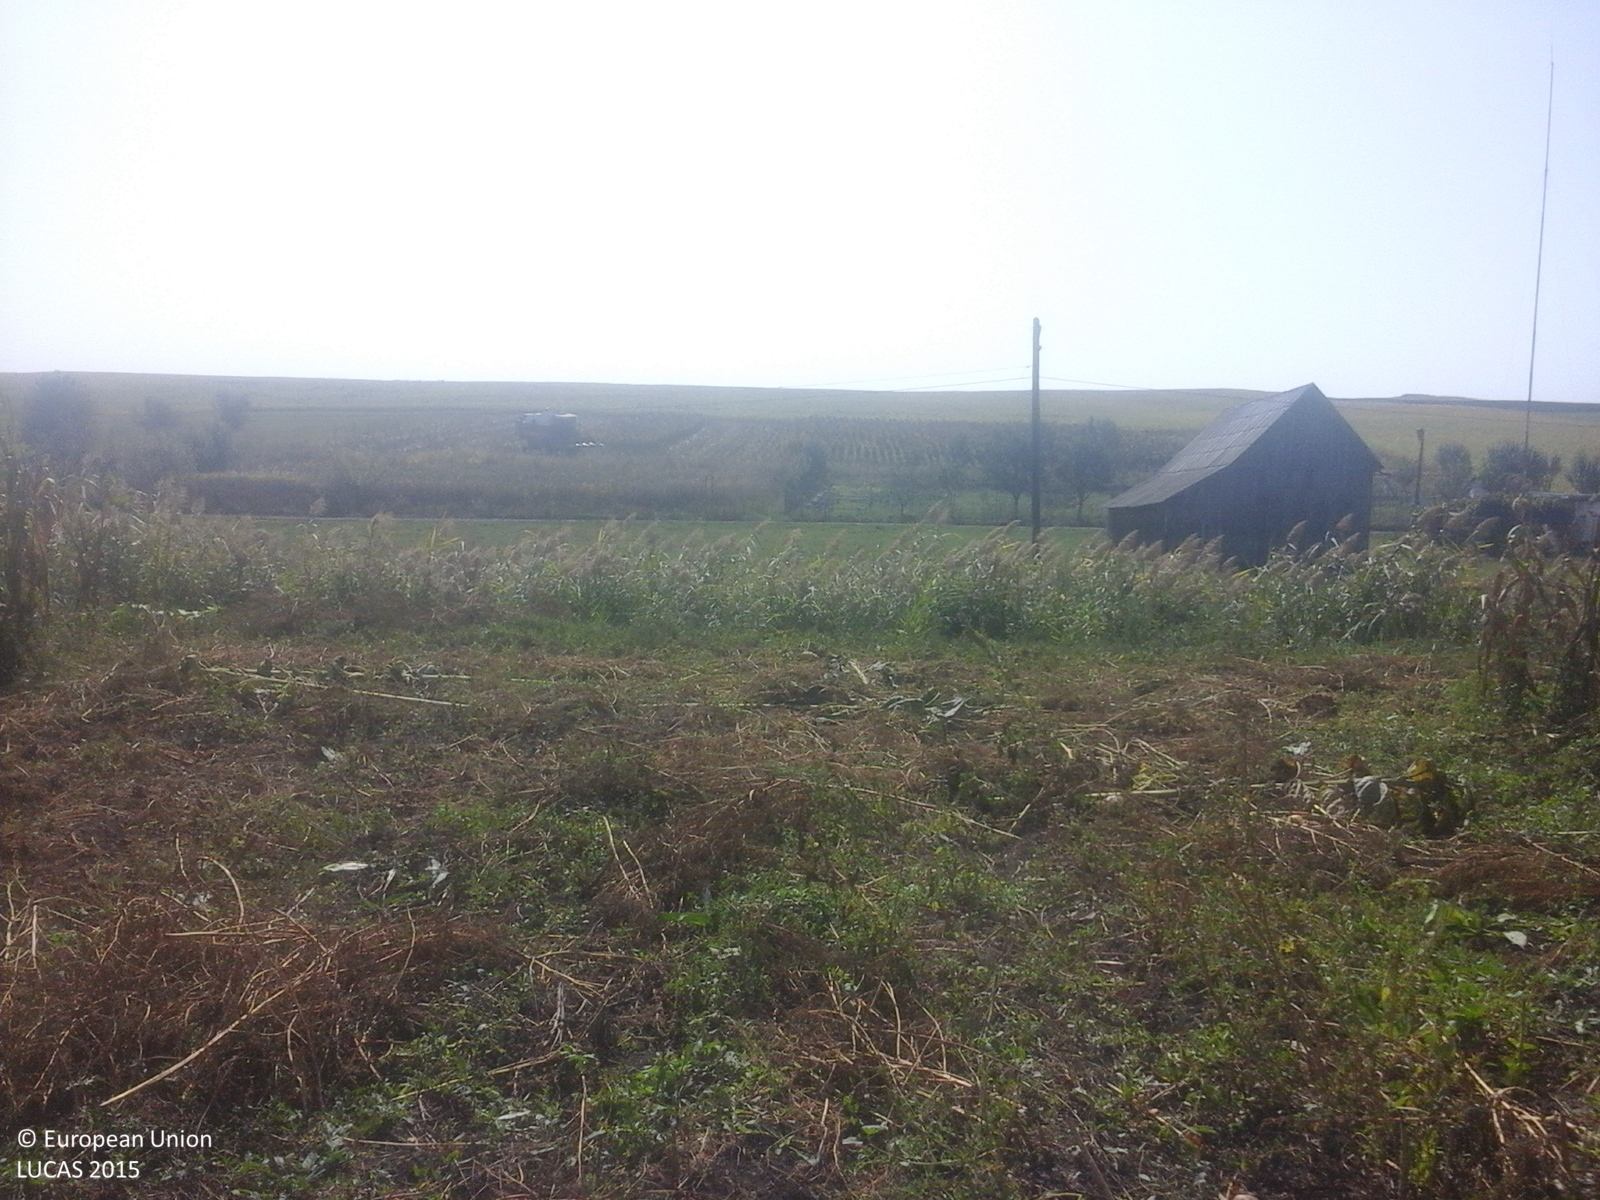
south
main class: Cropland
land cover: Potatoes
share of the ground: 50 - 75 %
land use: Agriculture (excluding fallow land and kitchen gardens)
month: September
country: RO
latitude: 46.7957
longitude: 24.4067
